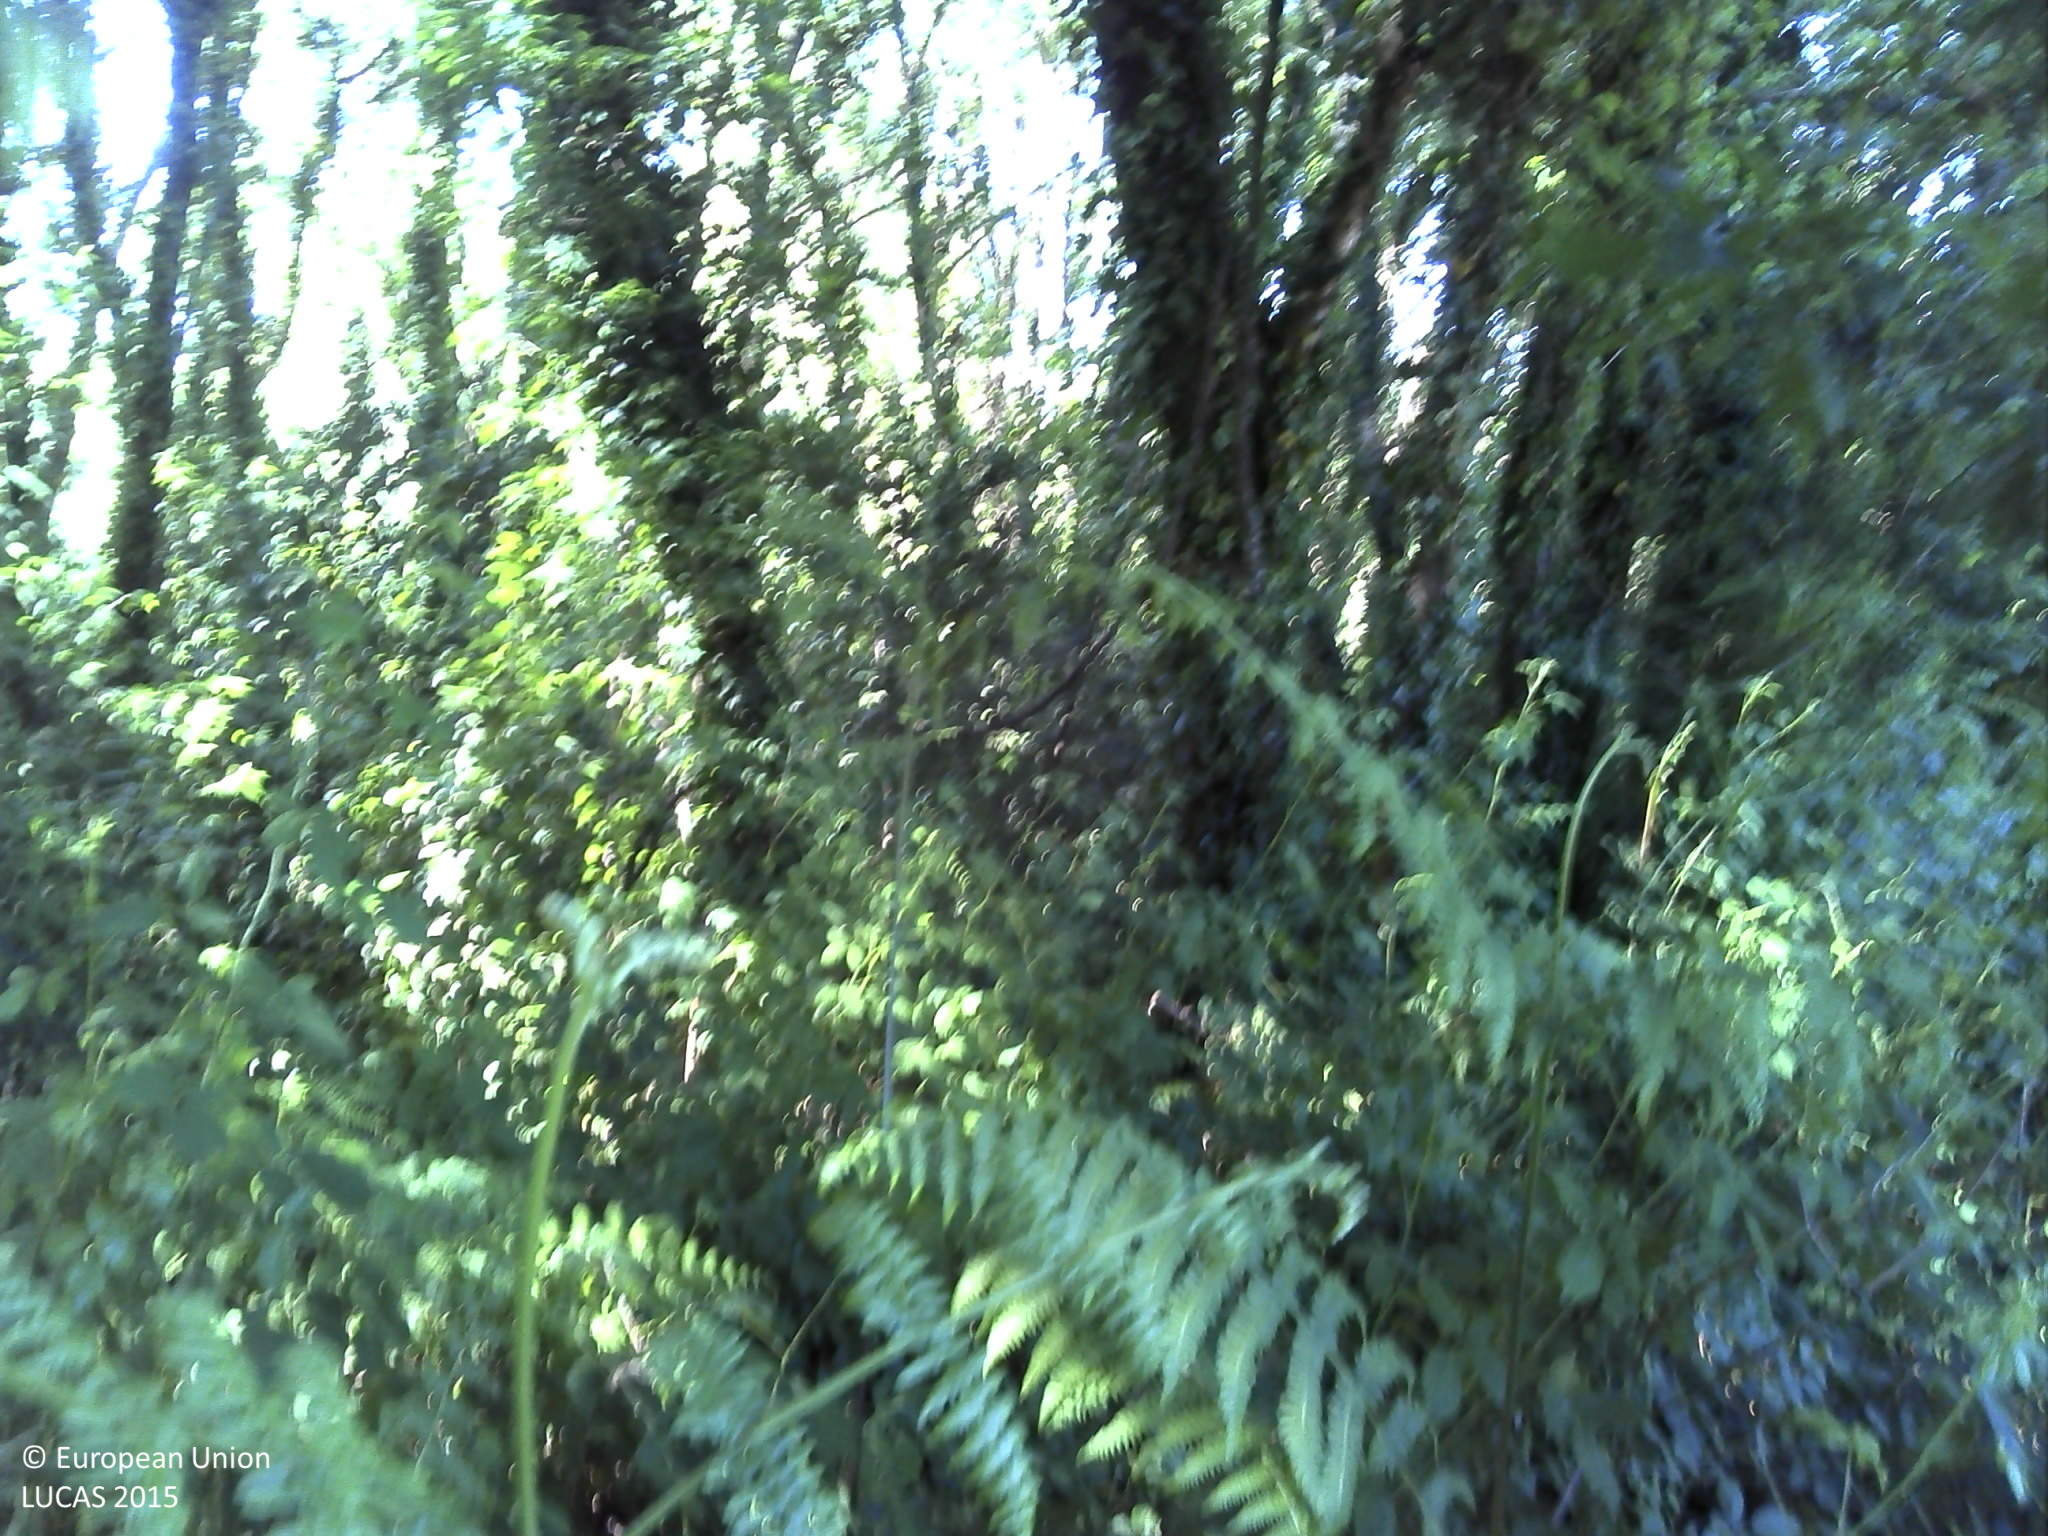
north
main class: Woodland
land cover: Broadleaved woodland
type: thermophilous deciduous forest
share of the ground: > 75 %
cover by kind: broadleaved forest trees 85 %, shrubs 15 %
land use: Forestry
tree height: > 5 m
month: May
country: PT
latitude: 41.9505
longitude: -8.6857
